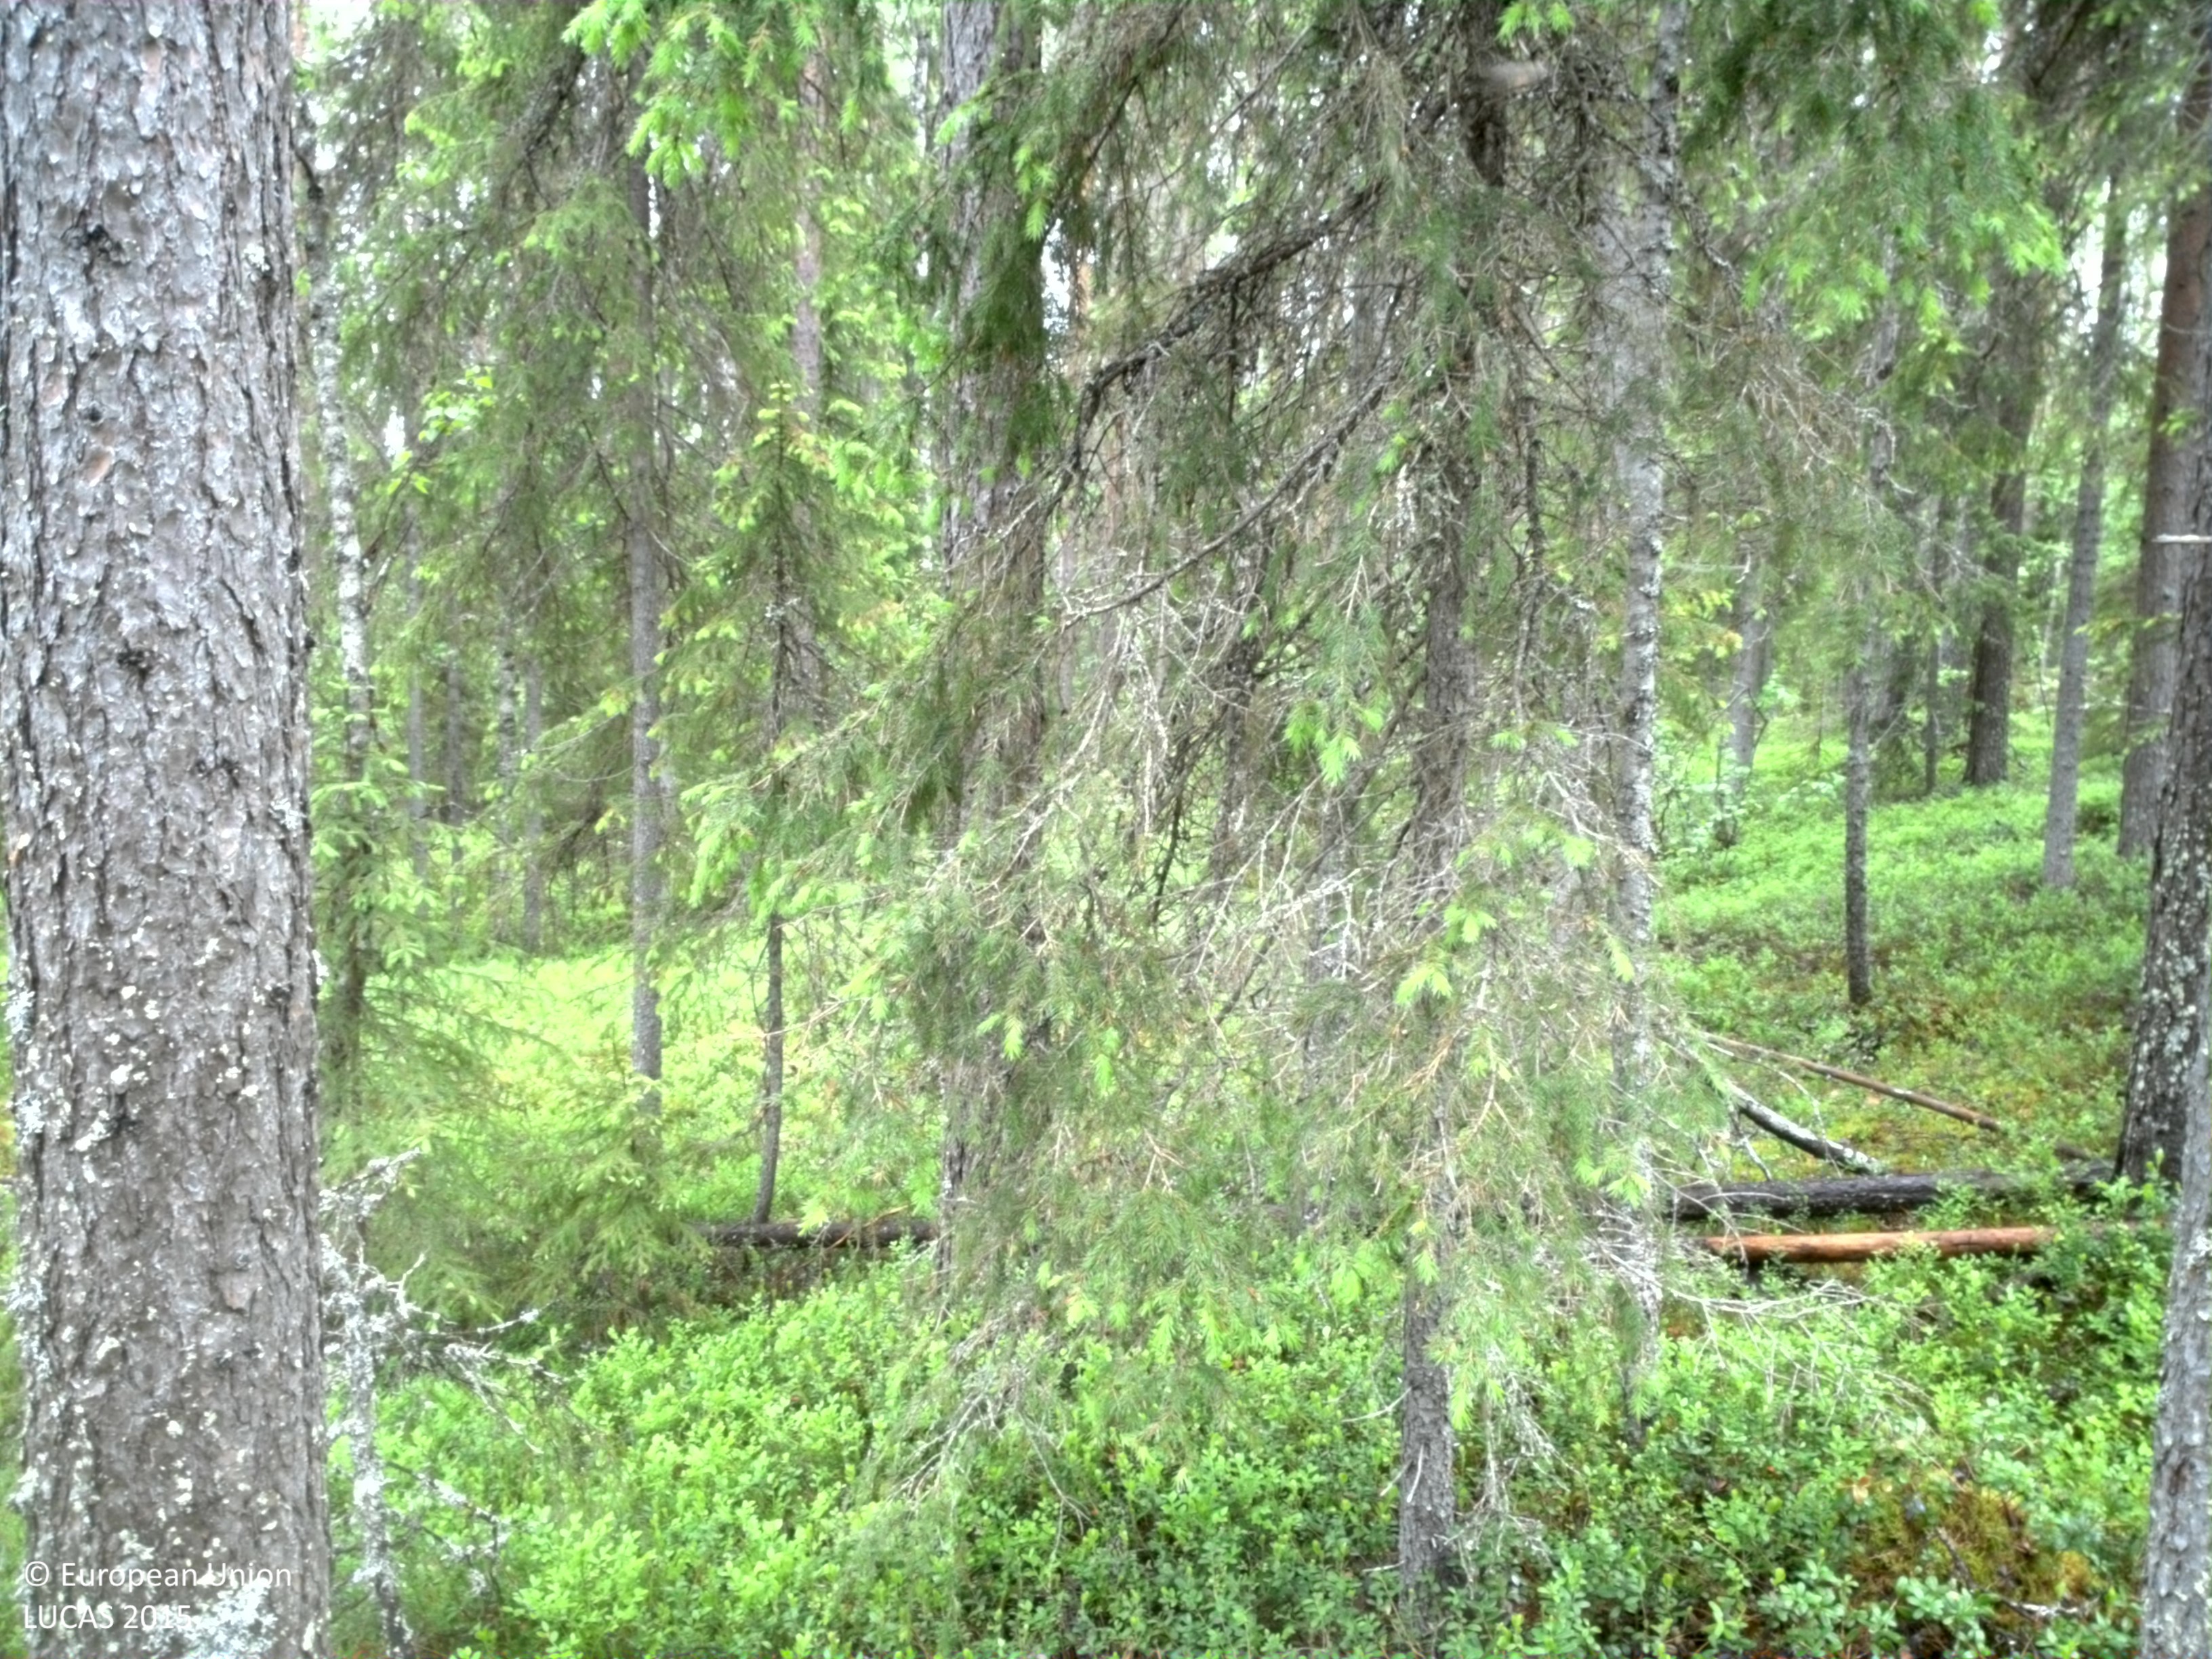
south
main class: Woodland
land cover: Pine dominated coniferous woodland
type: boreal forest
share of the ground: 50 - 75 %
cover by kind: coniferous forest trees 45 %, shrubs 45 %, broadleaved forest trees 10 %
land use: Forestry
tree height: > 5 m
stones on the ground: 10 - 25 %
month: June
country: SE
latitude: 66.4713
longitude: 22.7479
